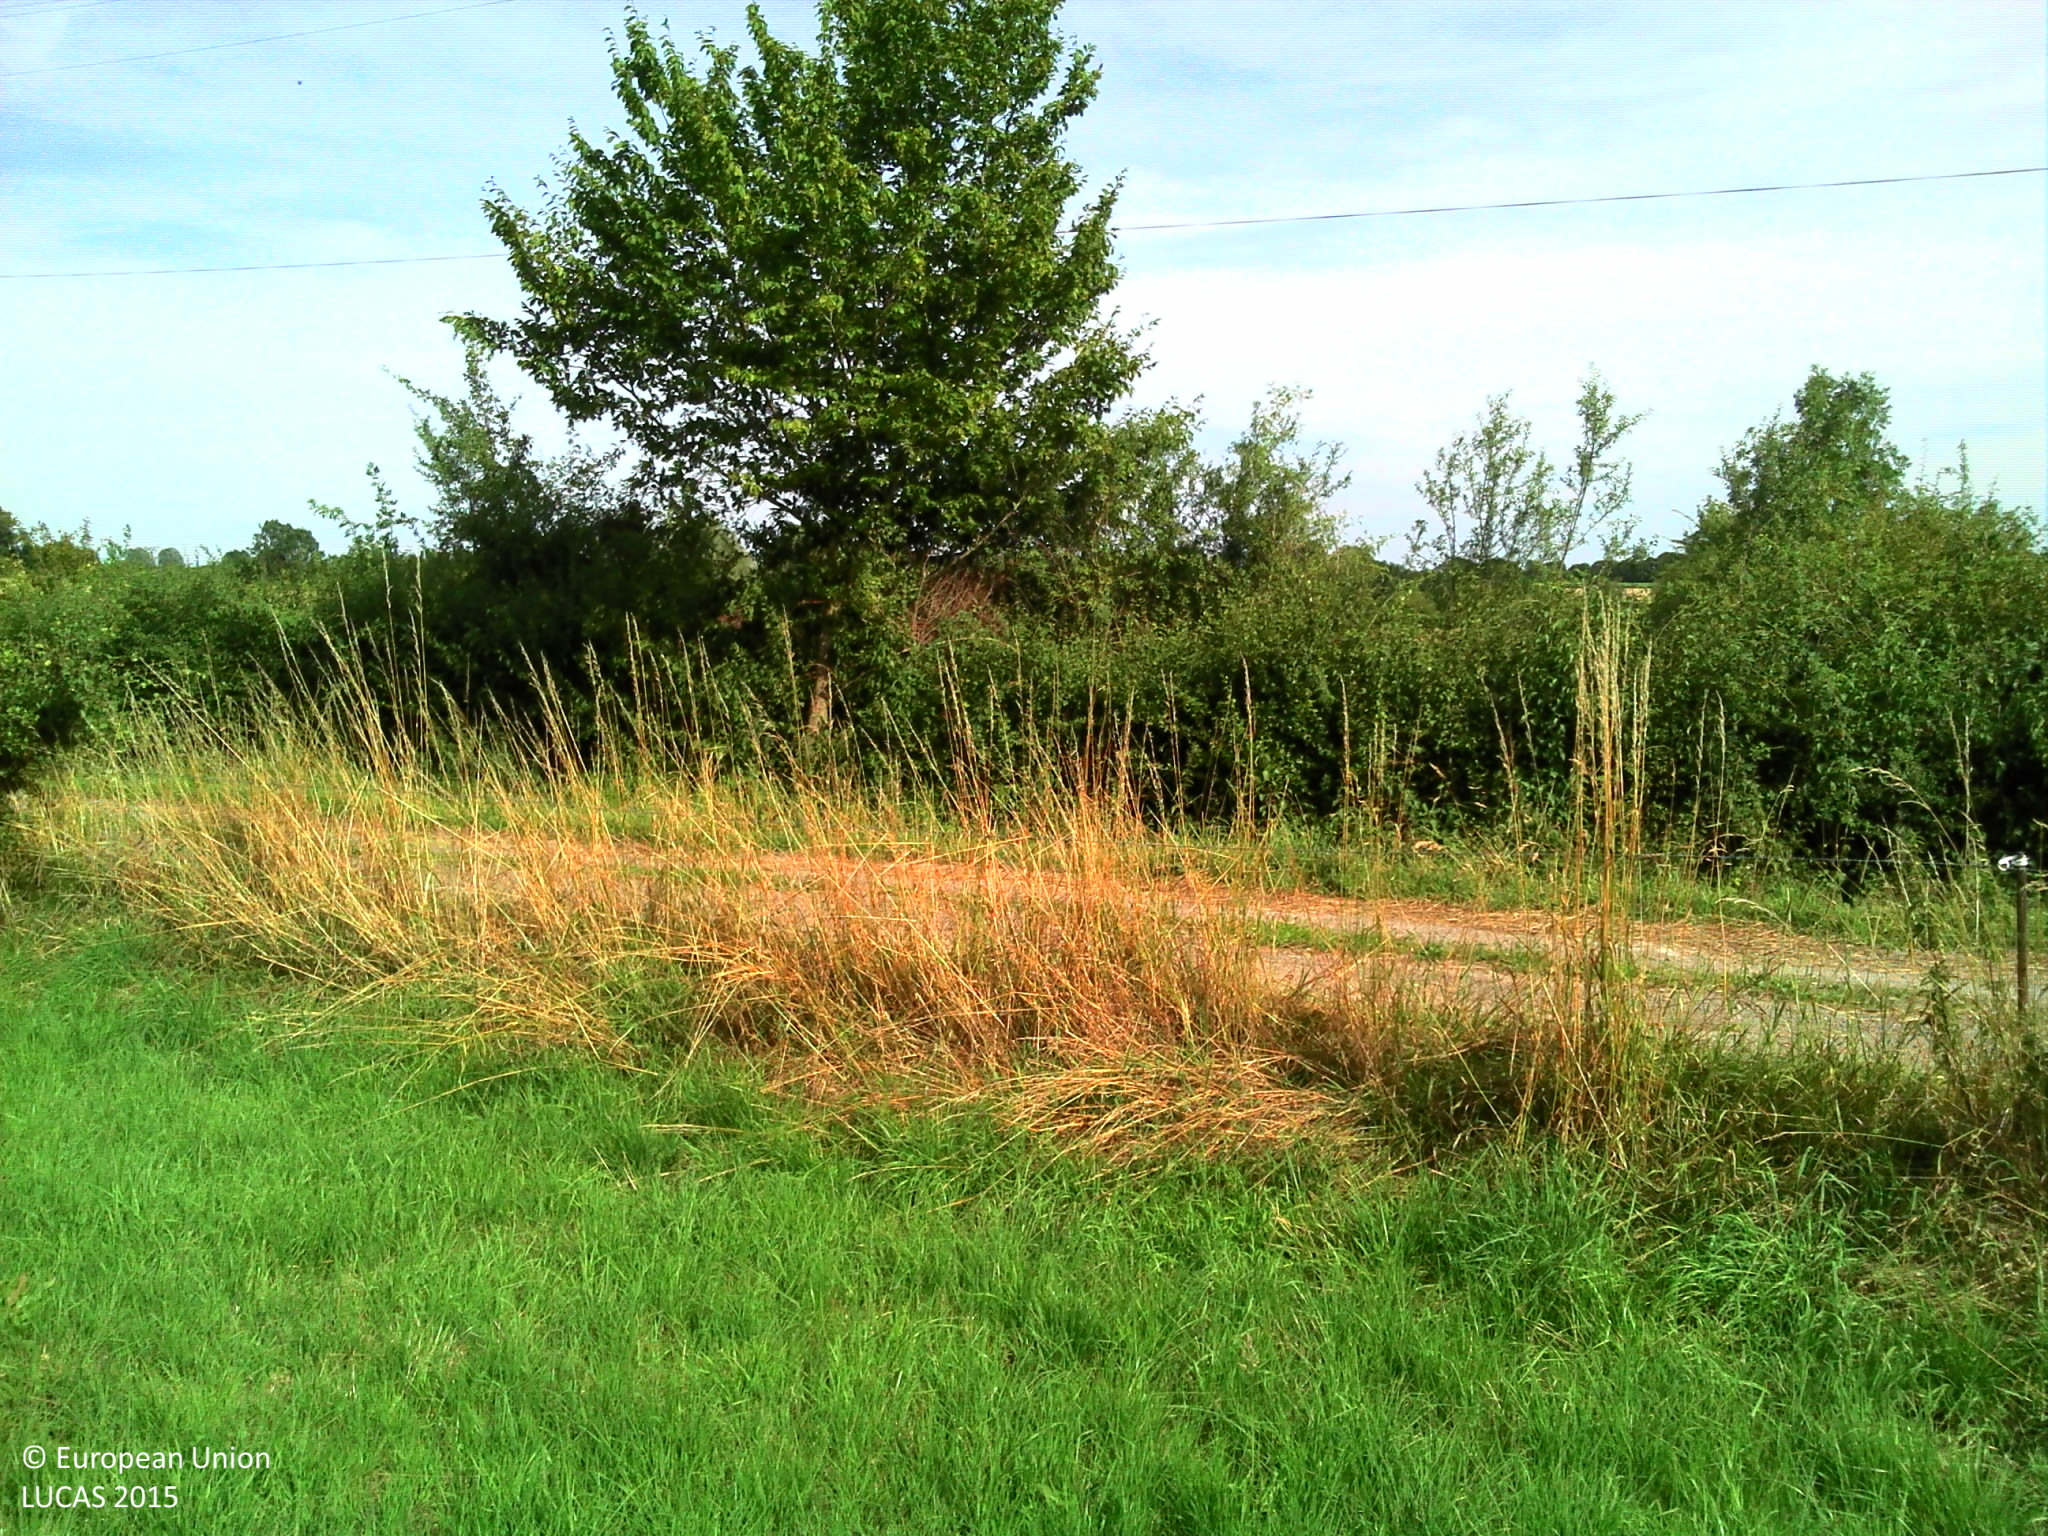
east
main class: Grassland
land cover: Grassland without tree/shrub cover
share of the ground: > 75 %
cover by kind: herbaceous plants 95 %, lichens and mosses 5 %
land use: Agriculture (excluding fallow land and kitchen gardens)
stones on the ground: < 10 %
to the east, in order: Grassland without tree/shrub cover; Fences; Grass margins; Tracks; Grass margins; Electric lines; Abandoned hedges; Grassland without tree/shrub cover; Abandoned hedges; Grassland without tree/shrub cover
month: August
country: FR
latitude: 50.0788
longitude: 3.9715
